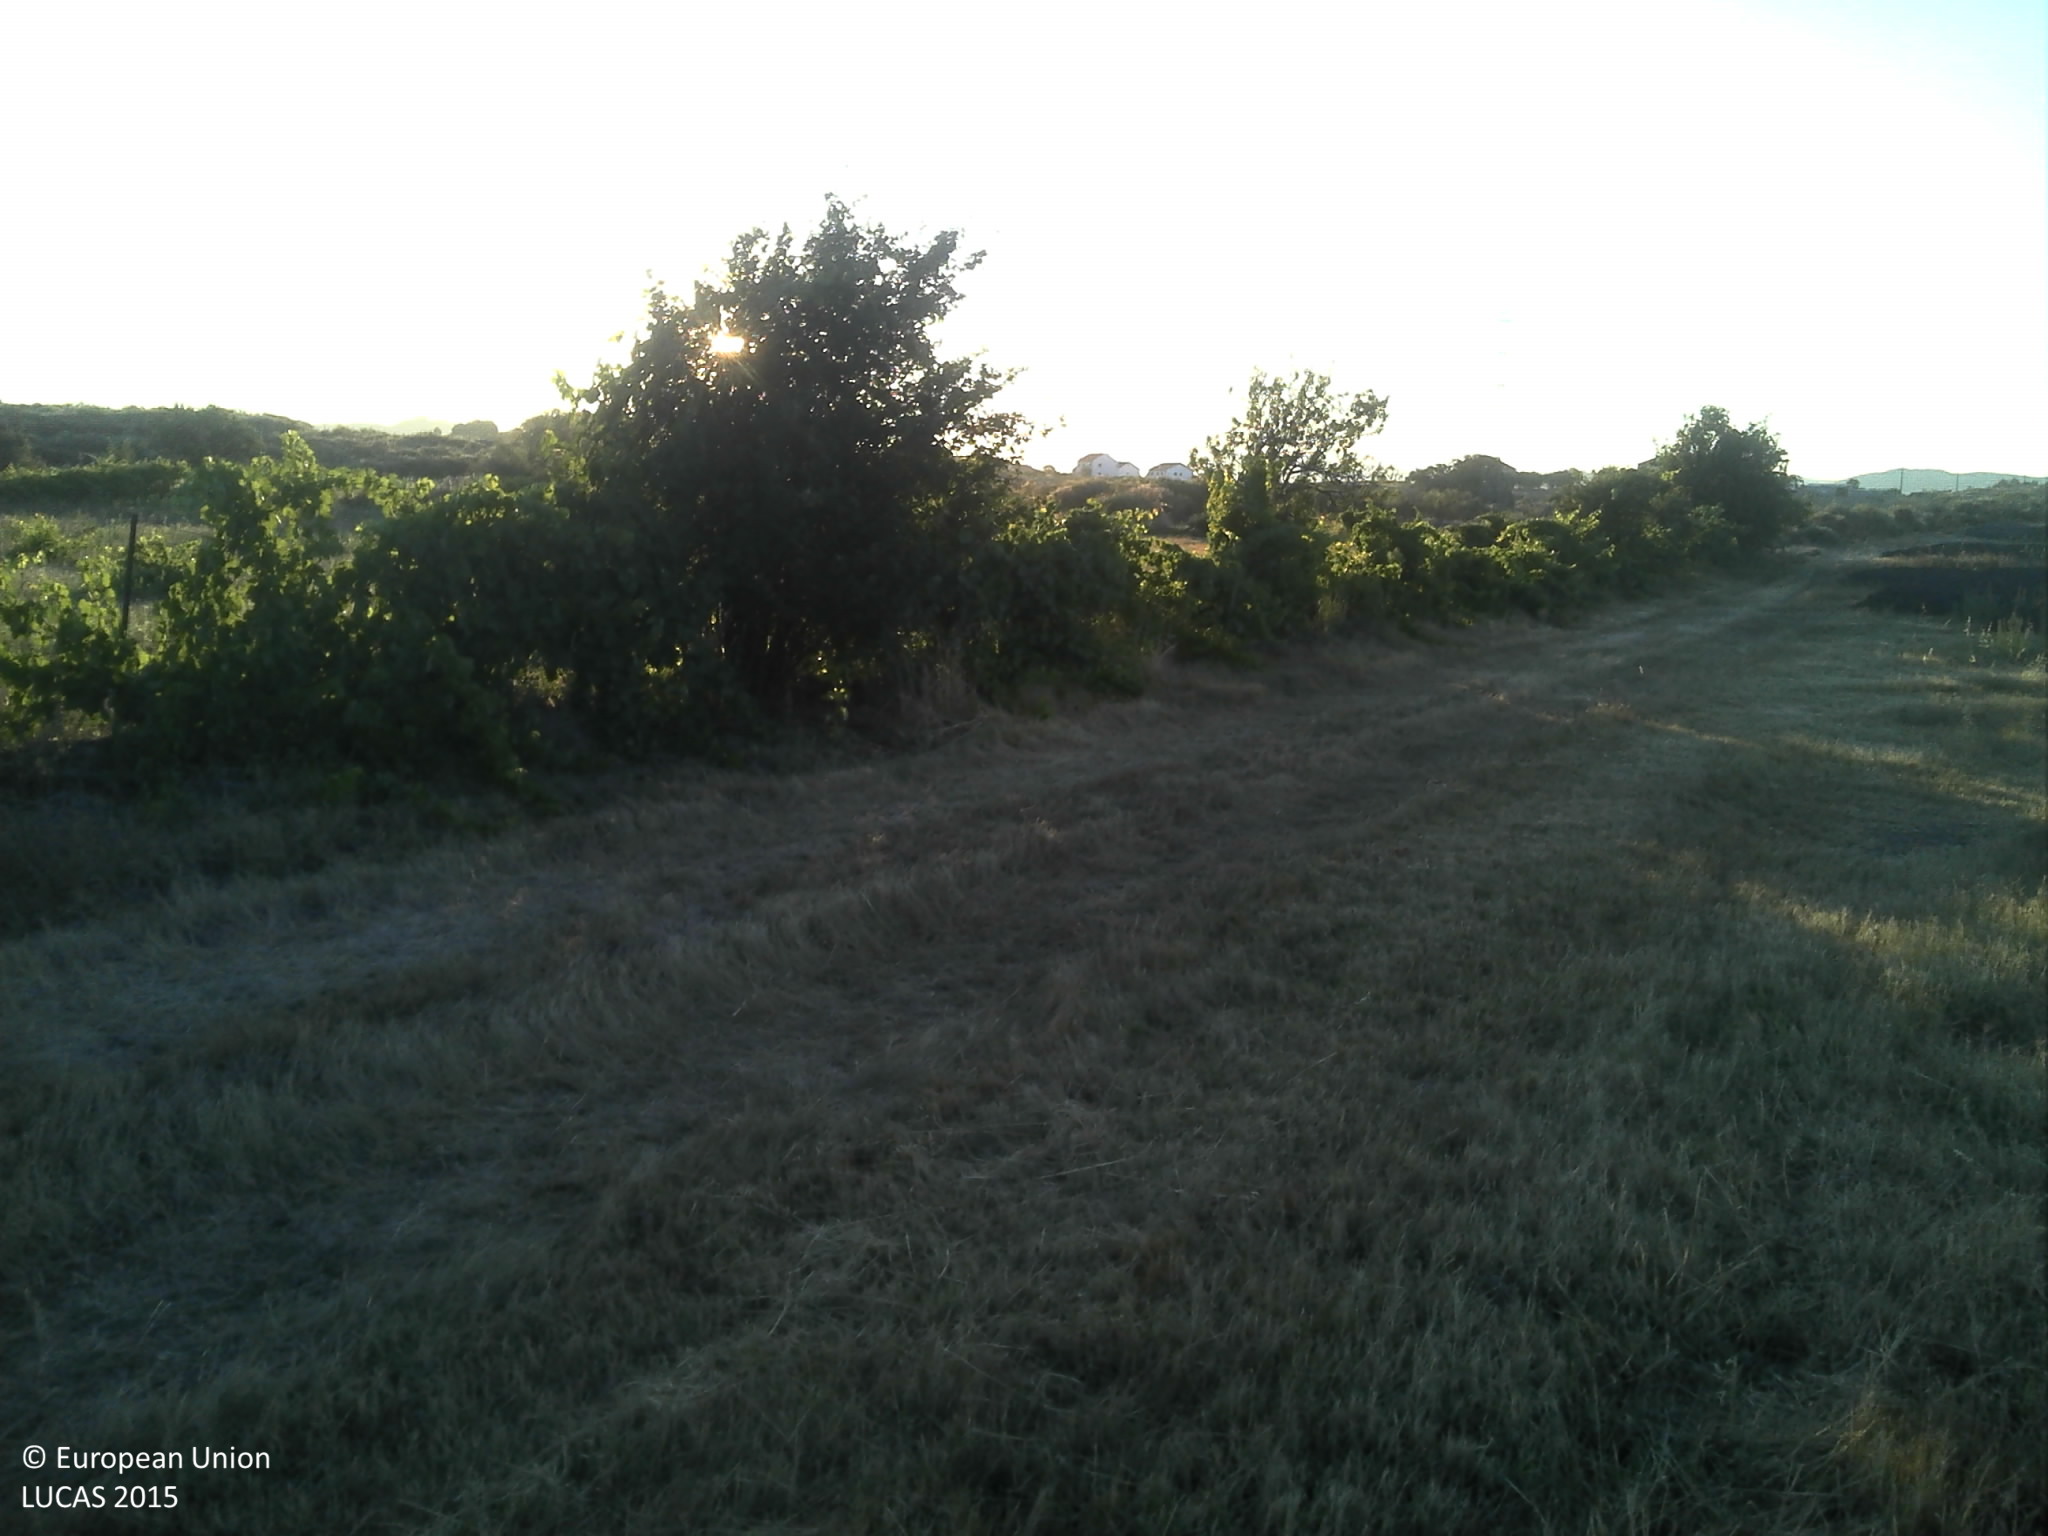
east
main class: Grassland
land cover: Grassland without tree/shrub cover
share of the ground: 50 - 75 %
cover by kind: herbaceous plants 55 %, unconsolidated bare surface 45 %
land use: Agriculture (excluding fallow land and kitchen gardens)
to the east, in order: Grassland without tree/shrub cover; Tracks; Fences; Vineyards; Oats; Fences; Ditches and canals; Shrubland without tree cover; Grassland without tree/shrub cover
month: July
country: PT
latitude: 40.3322
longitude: -7.3481
